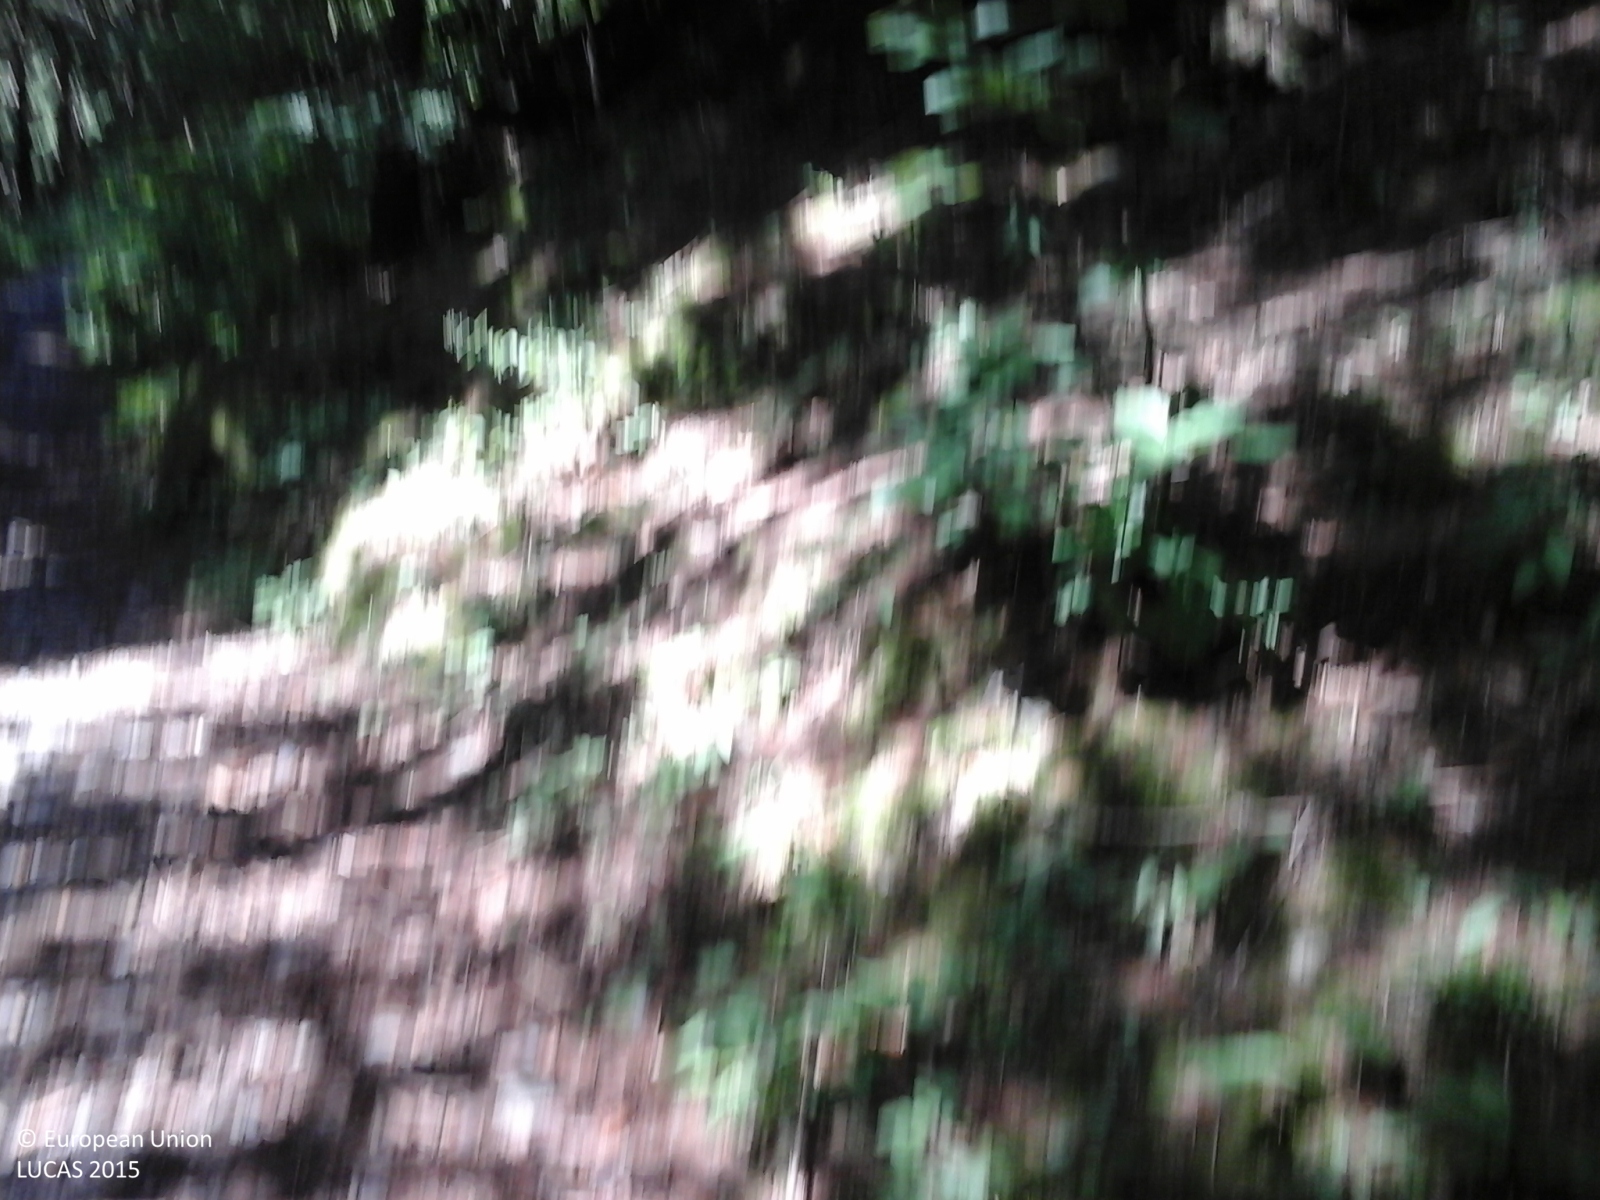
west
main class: Woodland
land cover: Spruce dominated coniferous woodland
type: alpine coniferous forest
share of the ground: > 75 %
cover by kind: coniferous forest trees 75 %, broadleaved forest trees 25 %
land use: Semi-natural and natural areas not in use
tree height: > 5 m
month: July
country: IT
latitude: 46.0089
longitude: 10.1161
